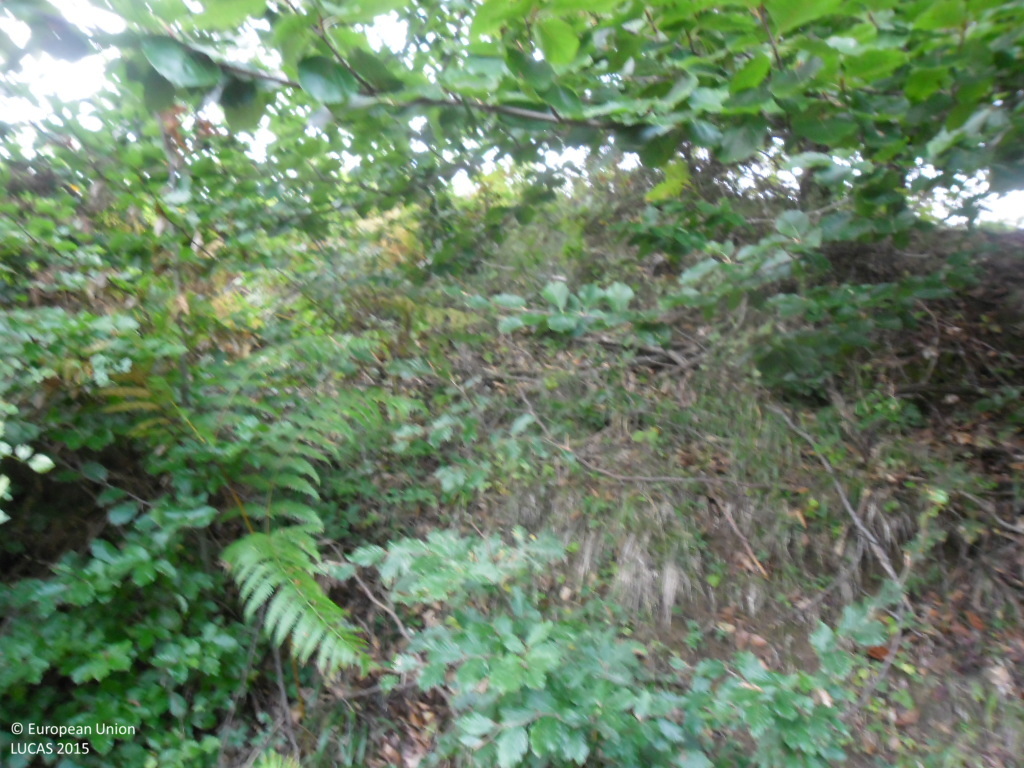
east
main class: Woodland
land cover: Broadleaved woodland
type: mesophytic deciduous forest
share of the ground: > 75 %
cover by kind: broadleaved forest trees 95 %, unconsolidated bare surface 5 %
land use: Forestry
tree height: > 5 m
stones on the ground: < 10 %
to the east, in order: Broadleaved woodland; Tracks; Grass margins; Tracks; Grassland without tree/shrub cover; Tracks; Grassland without tree/shrub cover; Broadleaved woodland
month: September
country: BG
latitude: 41.5823
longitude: 23.0816
